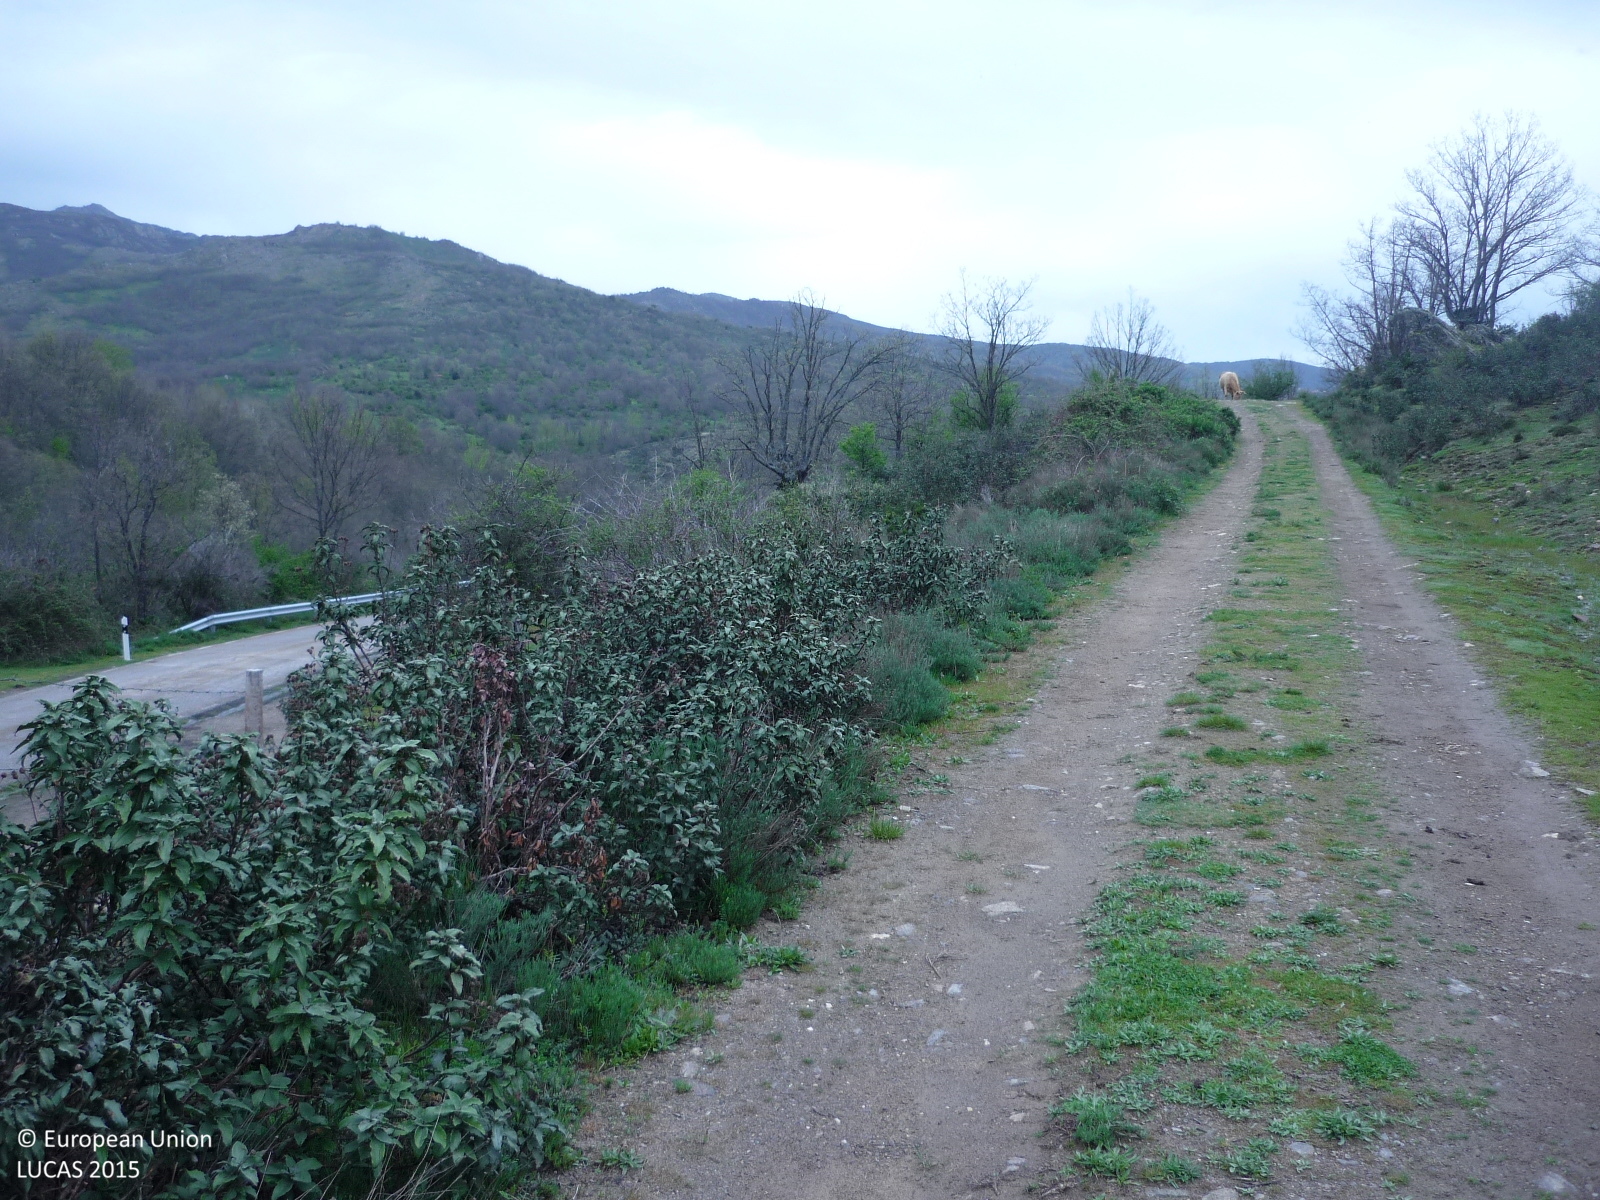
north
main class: Woodland
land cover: Broadleaved woodland
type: thermophilous deciduous forest
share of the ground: > 75 %
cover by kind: broadleaved forest trees 85 %, shrubs 10 %, unconsolidated bare surface 5 %
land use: Semi-natural and natural areas not in use
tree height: > 5 m
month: May
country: ES
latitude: 41.0780
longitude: -3.4325
